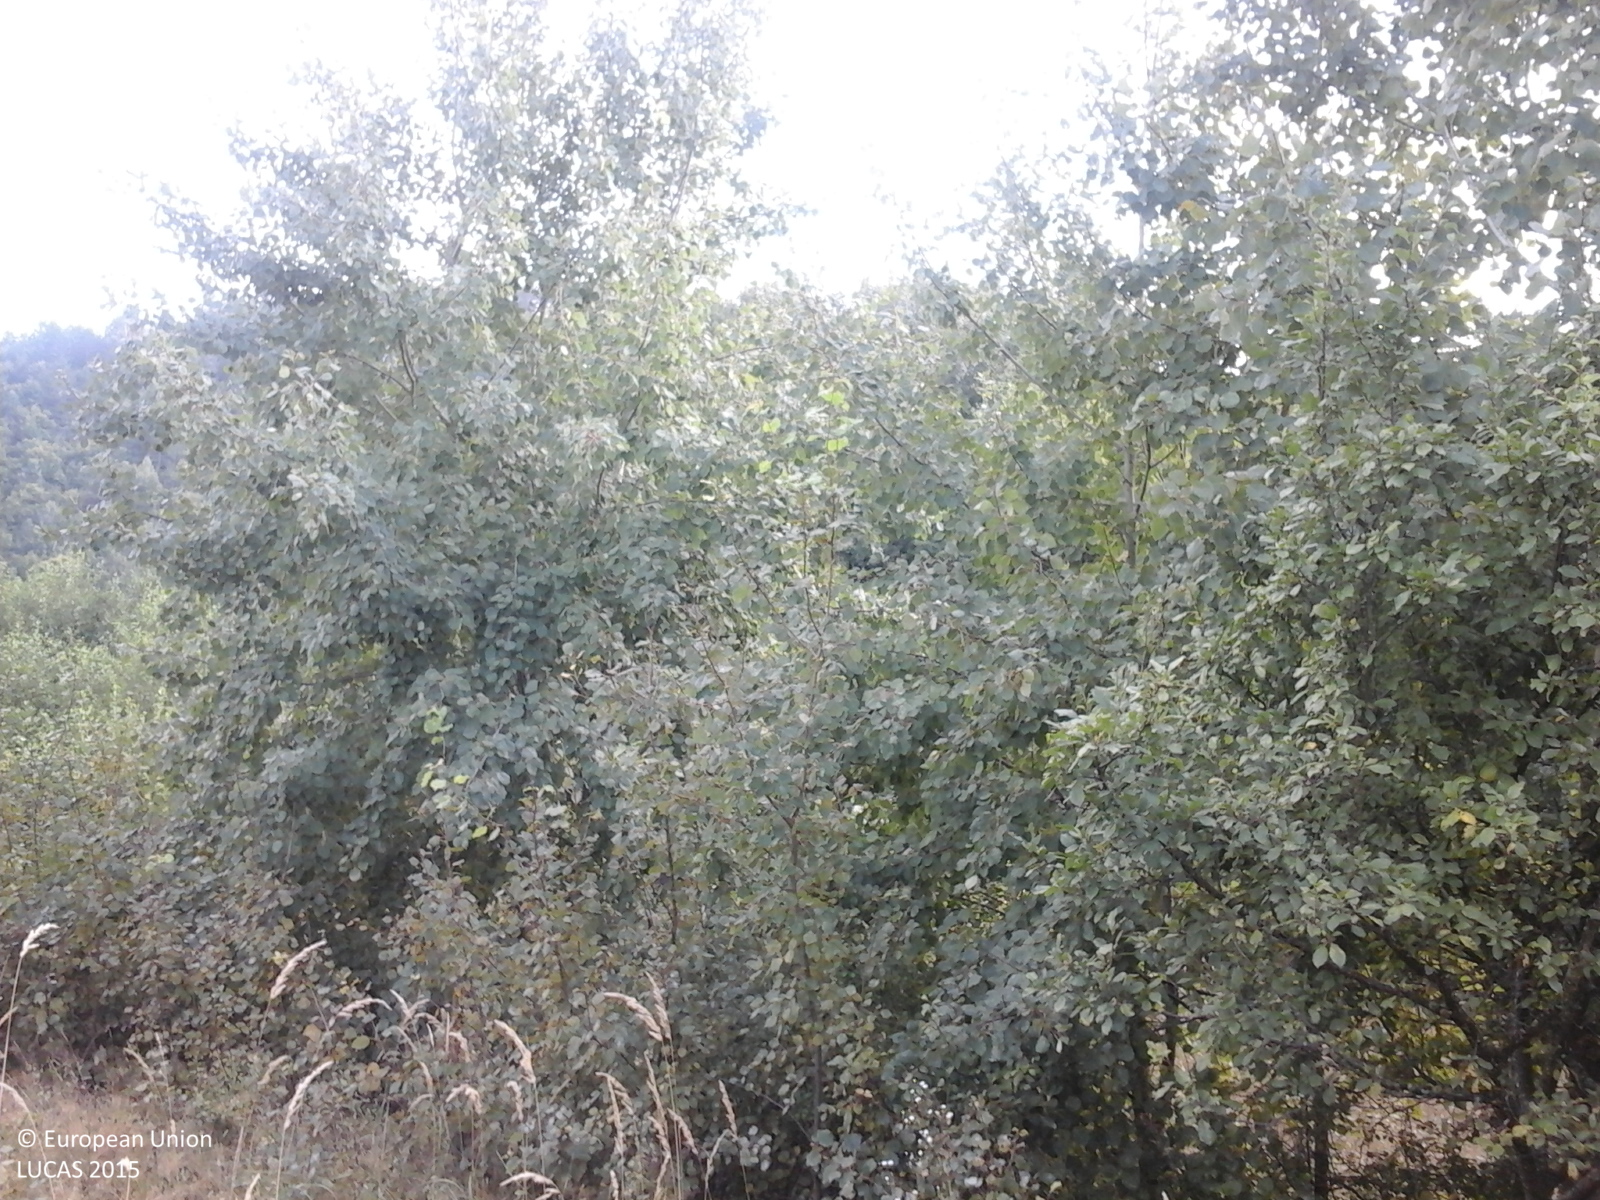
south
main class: Grassland
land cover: Grassland with sparse tree/shrub cover
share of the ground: > 75 %
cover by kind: herbaceous plants 85 %, shrubs 10 %, broadleaved forest trees 5 %
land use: Agriculture (excluding fallow land and kitchen gardens)
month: September
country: RO
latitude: 46.9296
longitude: 22.6250
